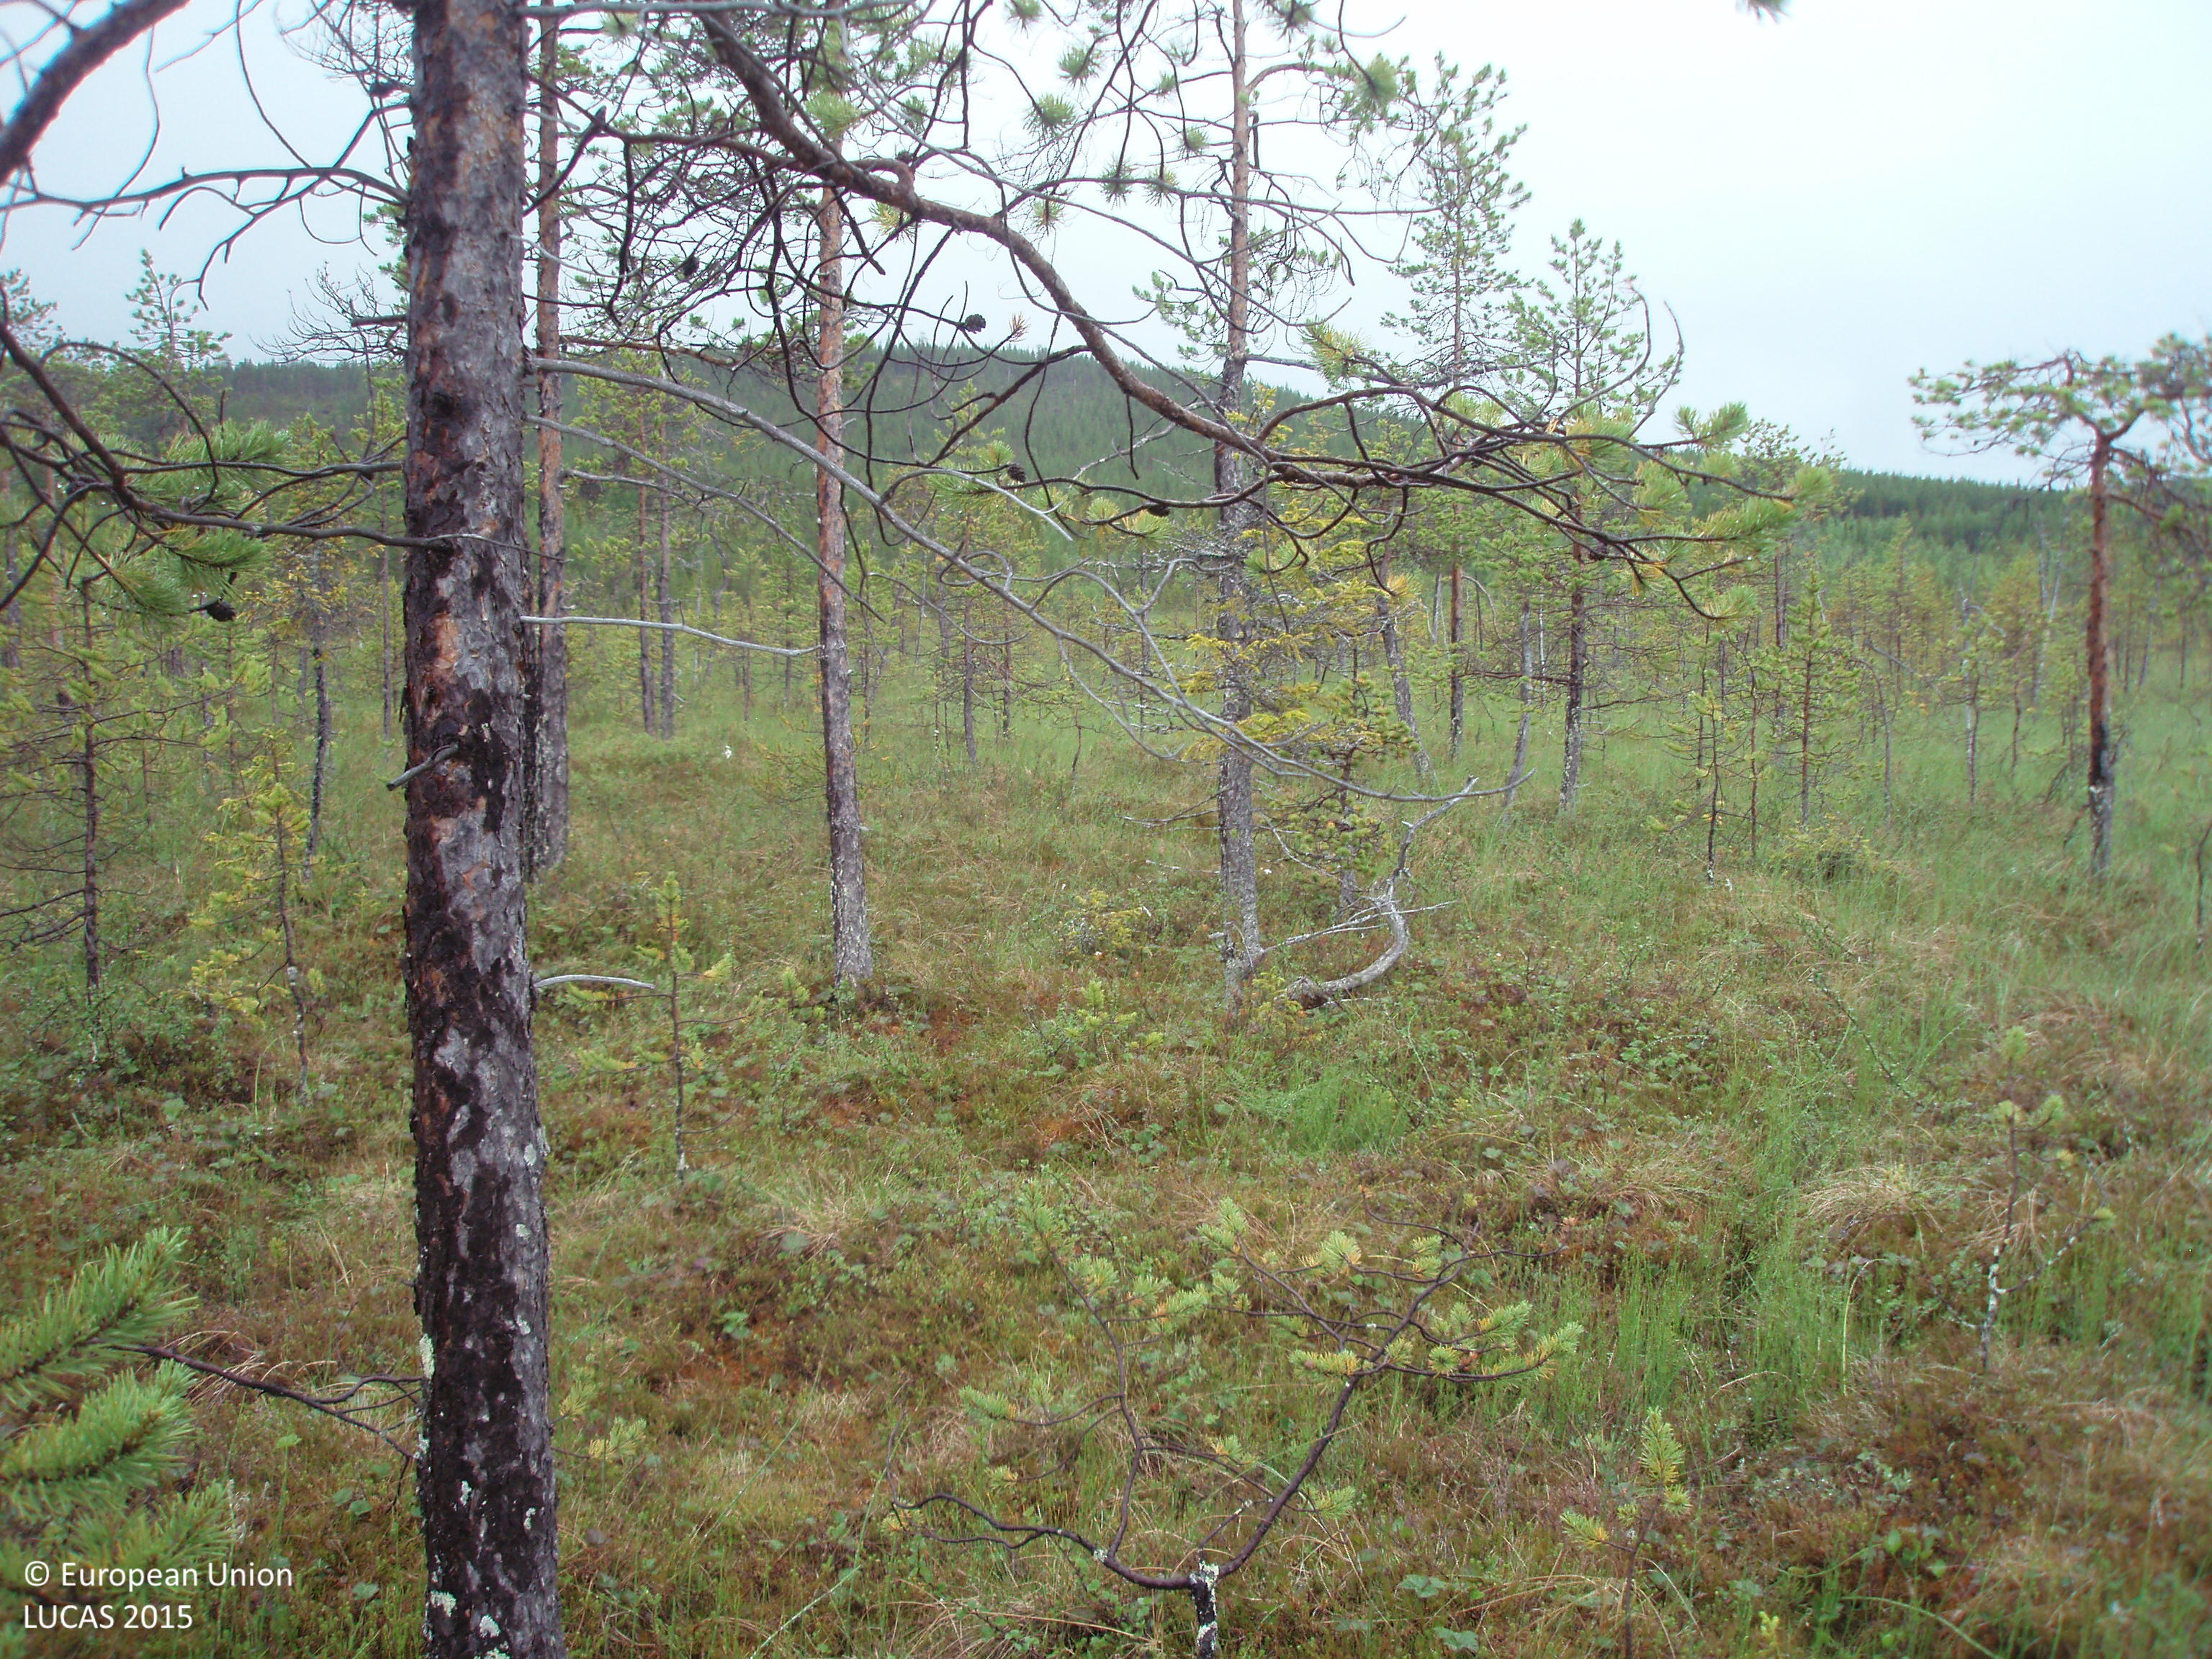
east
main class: Woodland
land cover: Pine dominated coniferous woodland
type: mire and swamp forests
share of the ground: 10 - 25 %
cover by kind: shrubs 45 %, lichens and mosses 35 %, coniferous forest trees 10 %, herbaceous plants 10 %
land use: Semi-natural and natural areas not in use
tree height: > 5 m
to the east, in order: Pine dominated coniferous woodland; Peatbogs; Pine dominated coniferous woodland; Pine dominated mixed woodland
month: July
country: FI
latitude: 66.7888
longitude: 28.5369
